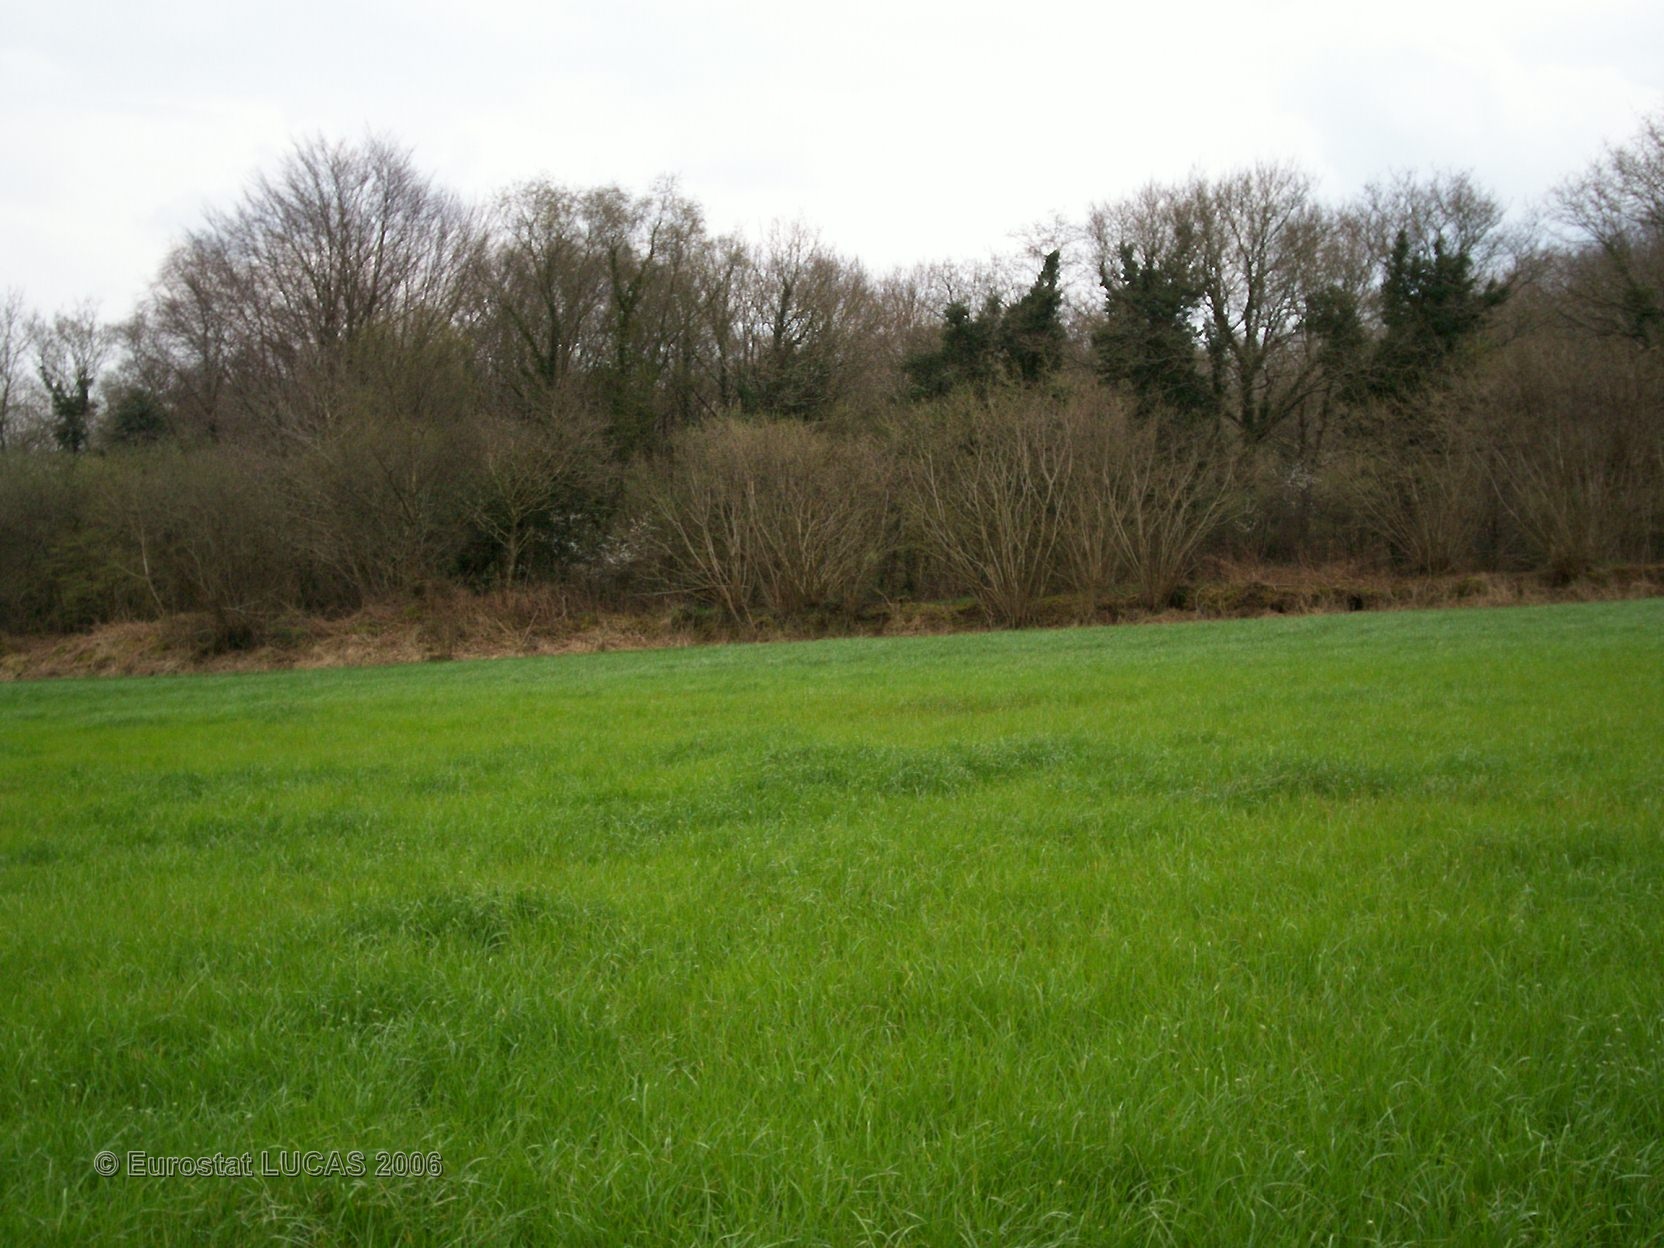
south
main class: Grassland
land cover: Grassland without tree/shrub cover
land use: Agriculture (excluding fallow land and kitchen gardens)
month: April
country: FR
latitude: 48.4791
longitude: -3.6780
